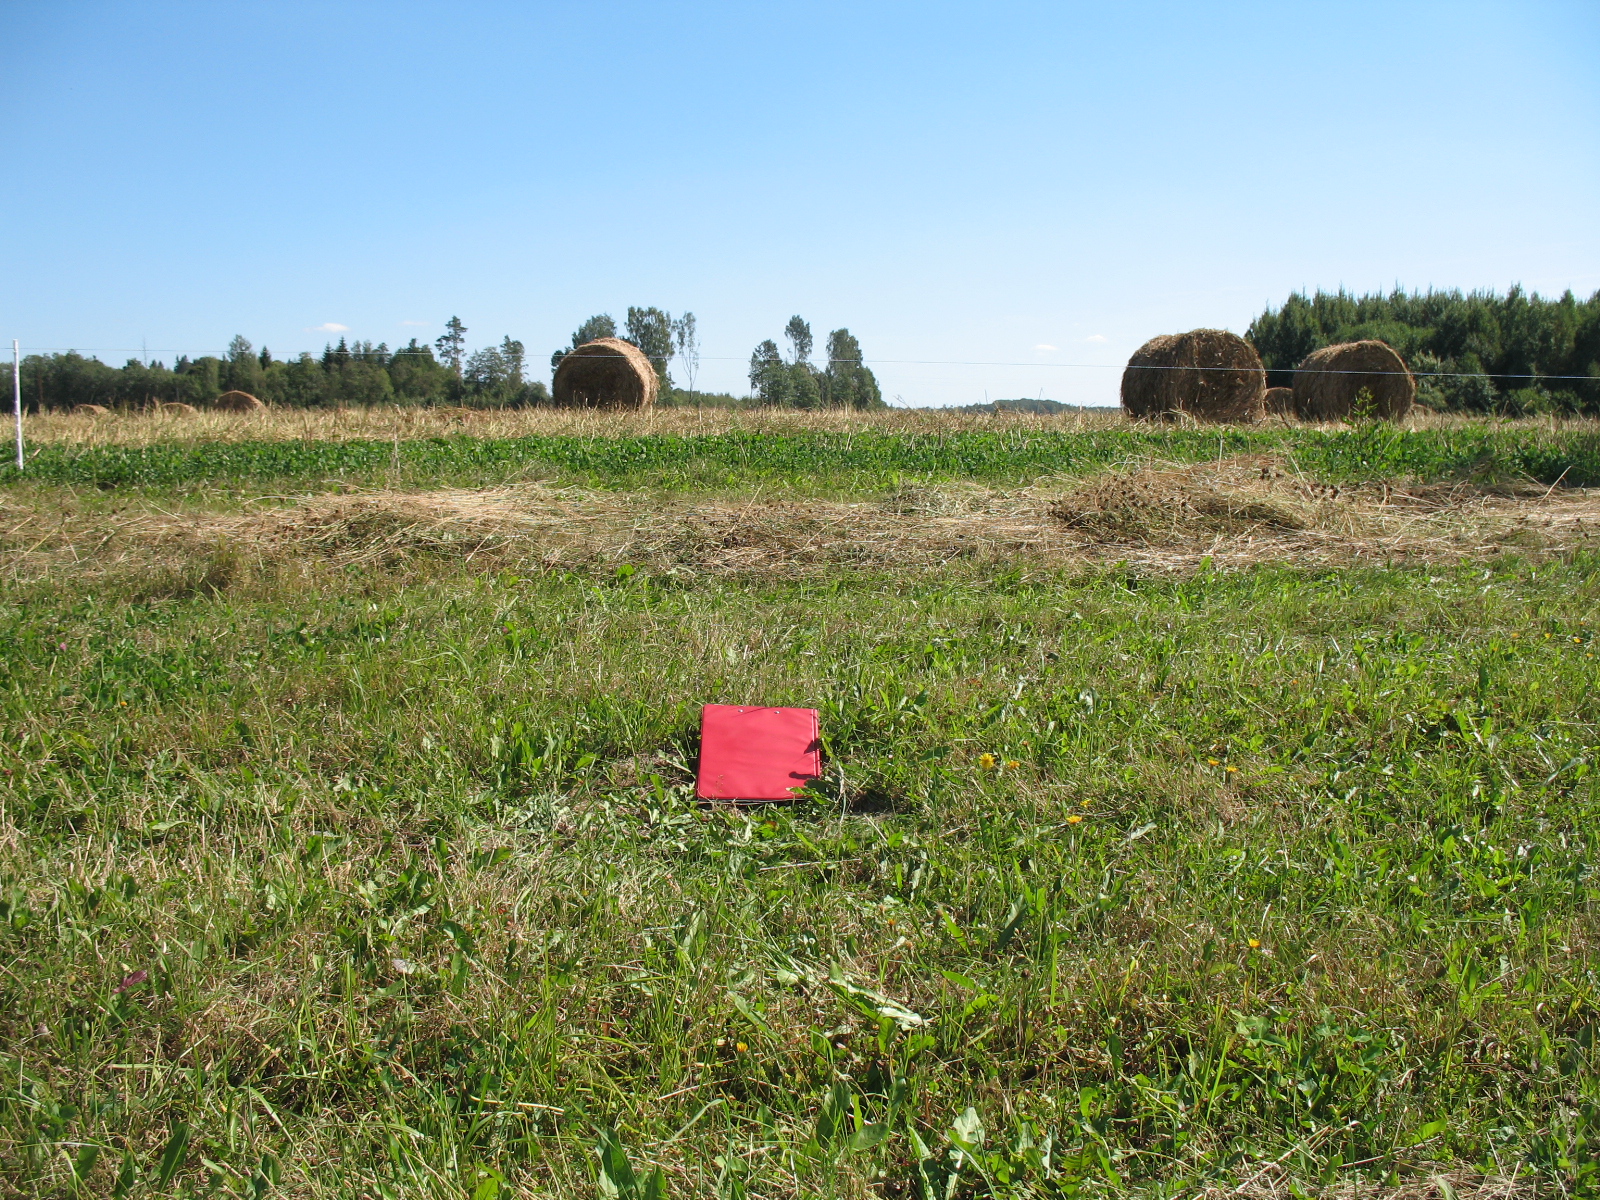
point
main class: Grassland
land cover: Grassland without tree/shrub cover
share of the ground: > 75 %
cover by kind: herbaceous plants 95 %, unconsolidated bare surface 5 %
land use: Agriculture (excluding fallow land and kitchen gardens)
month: August
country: LV
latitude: 56.4404
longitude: 26.0135
